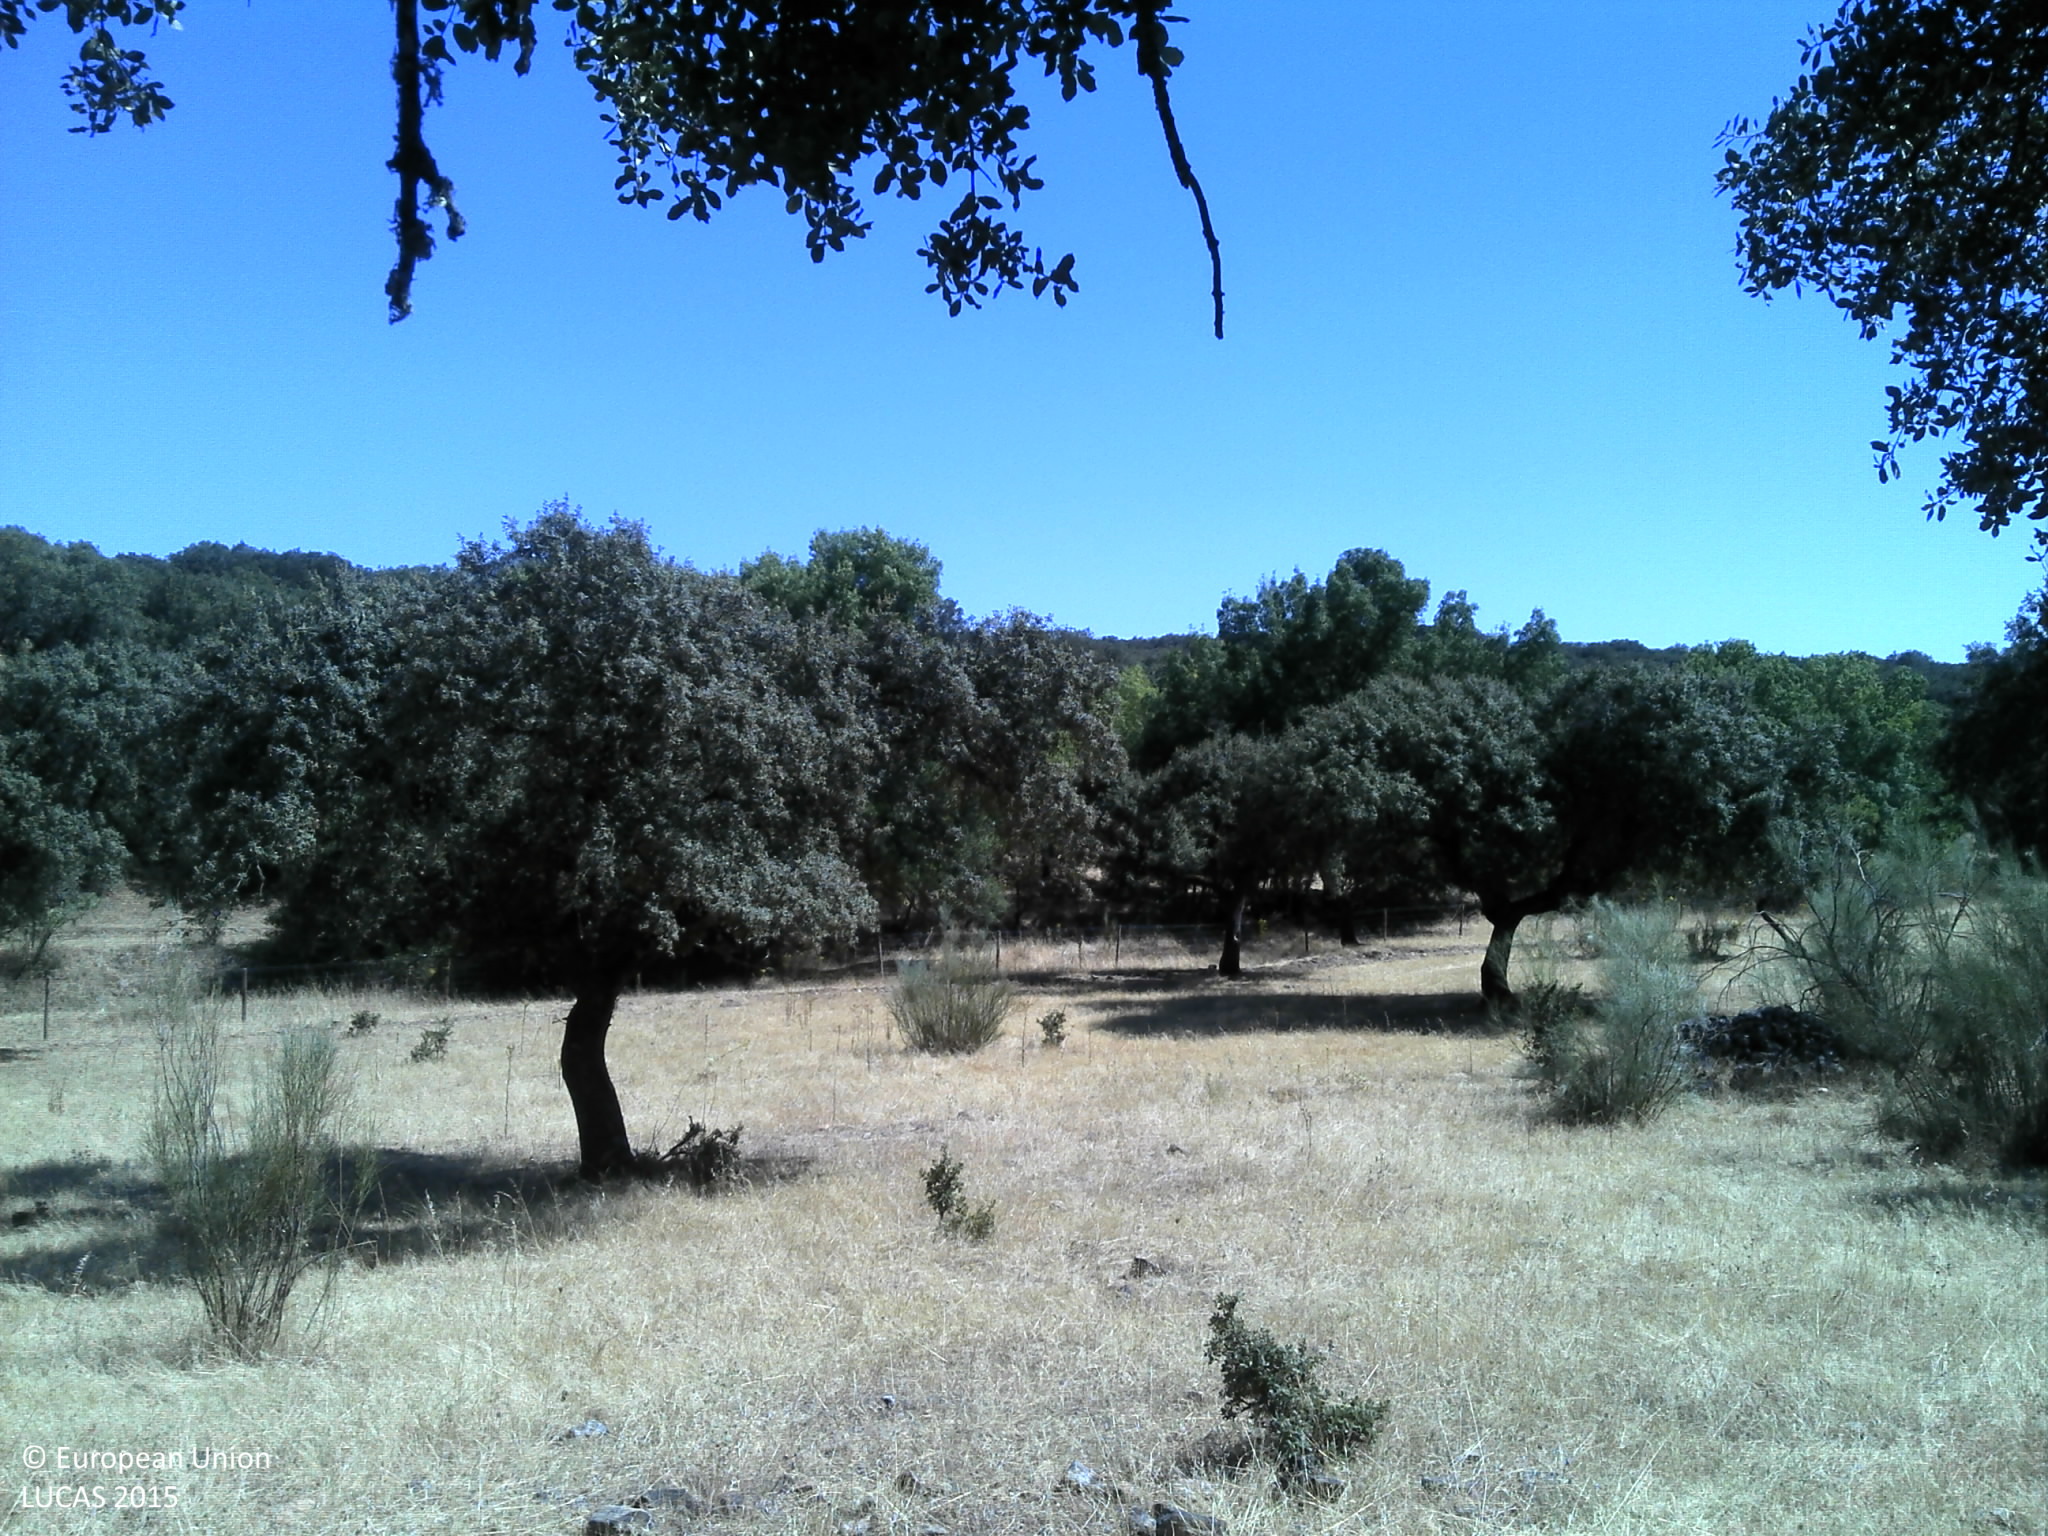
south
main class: Woodland
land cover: Broadleaved woodland
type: broadleaved evergreen forest
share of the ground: 25 - 50 %
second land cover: Grassland without tree/shrub cover
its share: 10 - 25 %
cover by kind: unconsolidated bare surface 60 %, broadleaved forest trees 25 %, herbaceous plants 10 %, shrubs 5 %
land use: Forestry
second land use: Agriculture (excluding fallow land and kitchen gardens)
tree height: > 5 m
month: July
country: PT
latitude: 39.0813
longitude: -7.5301
